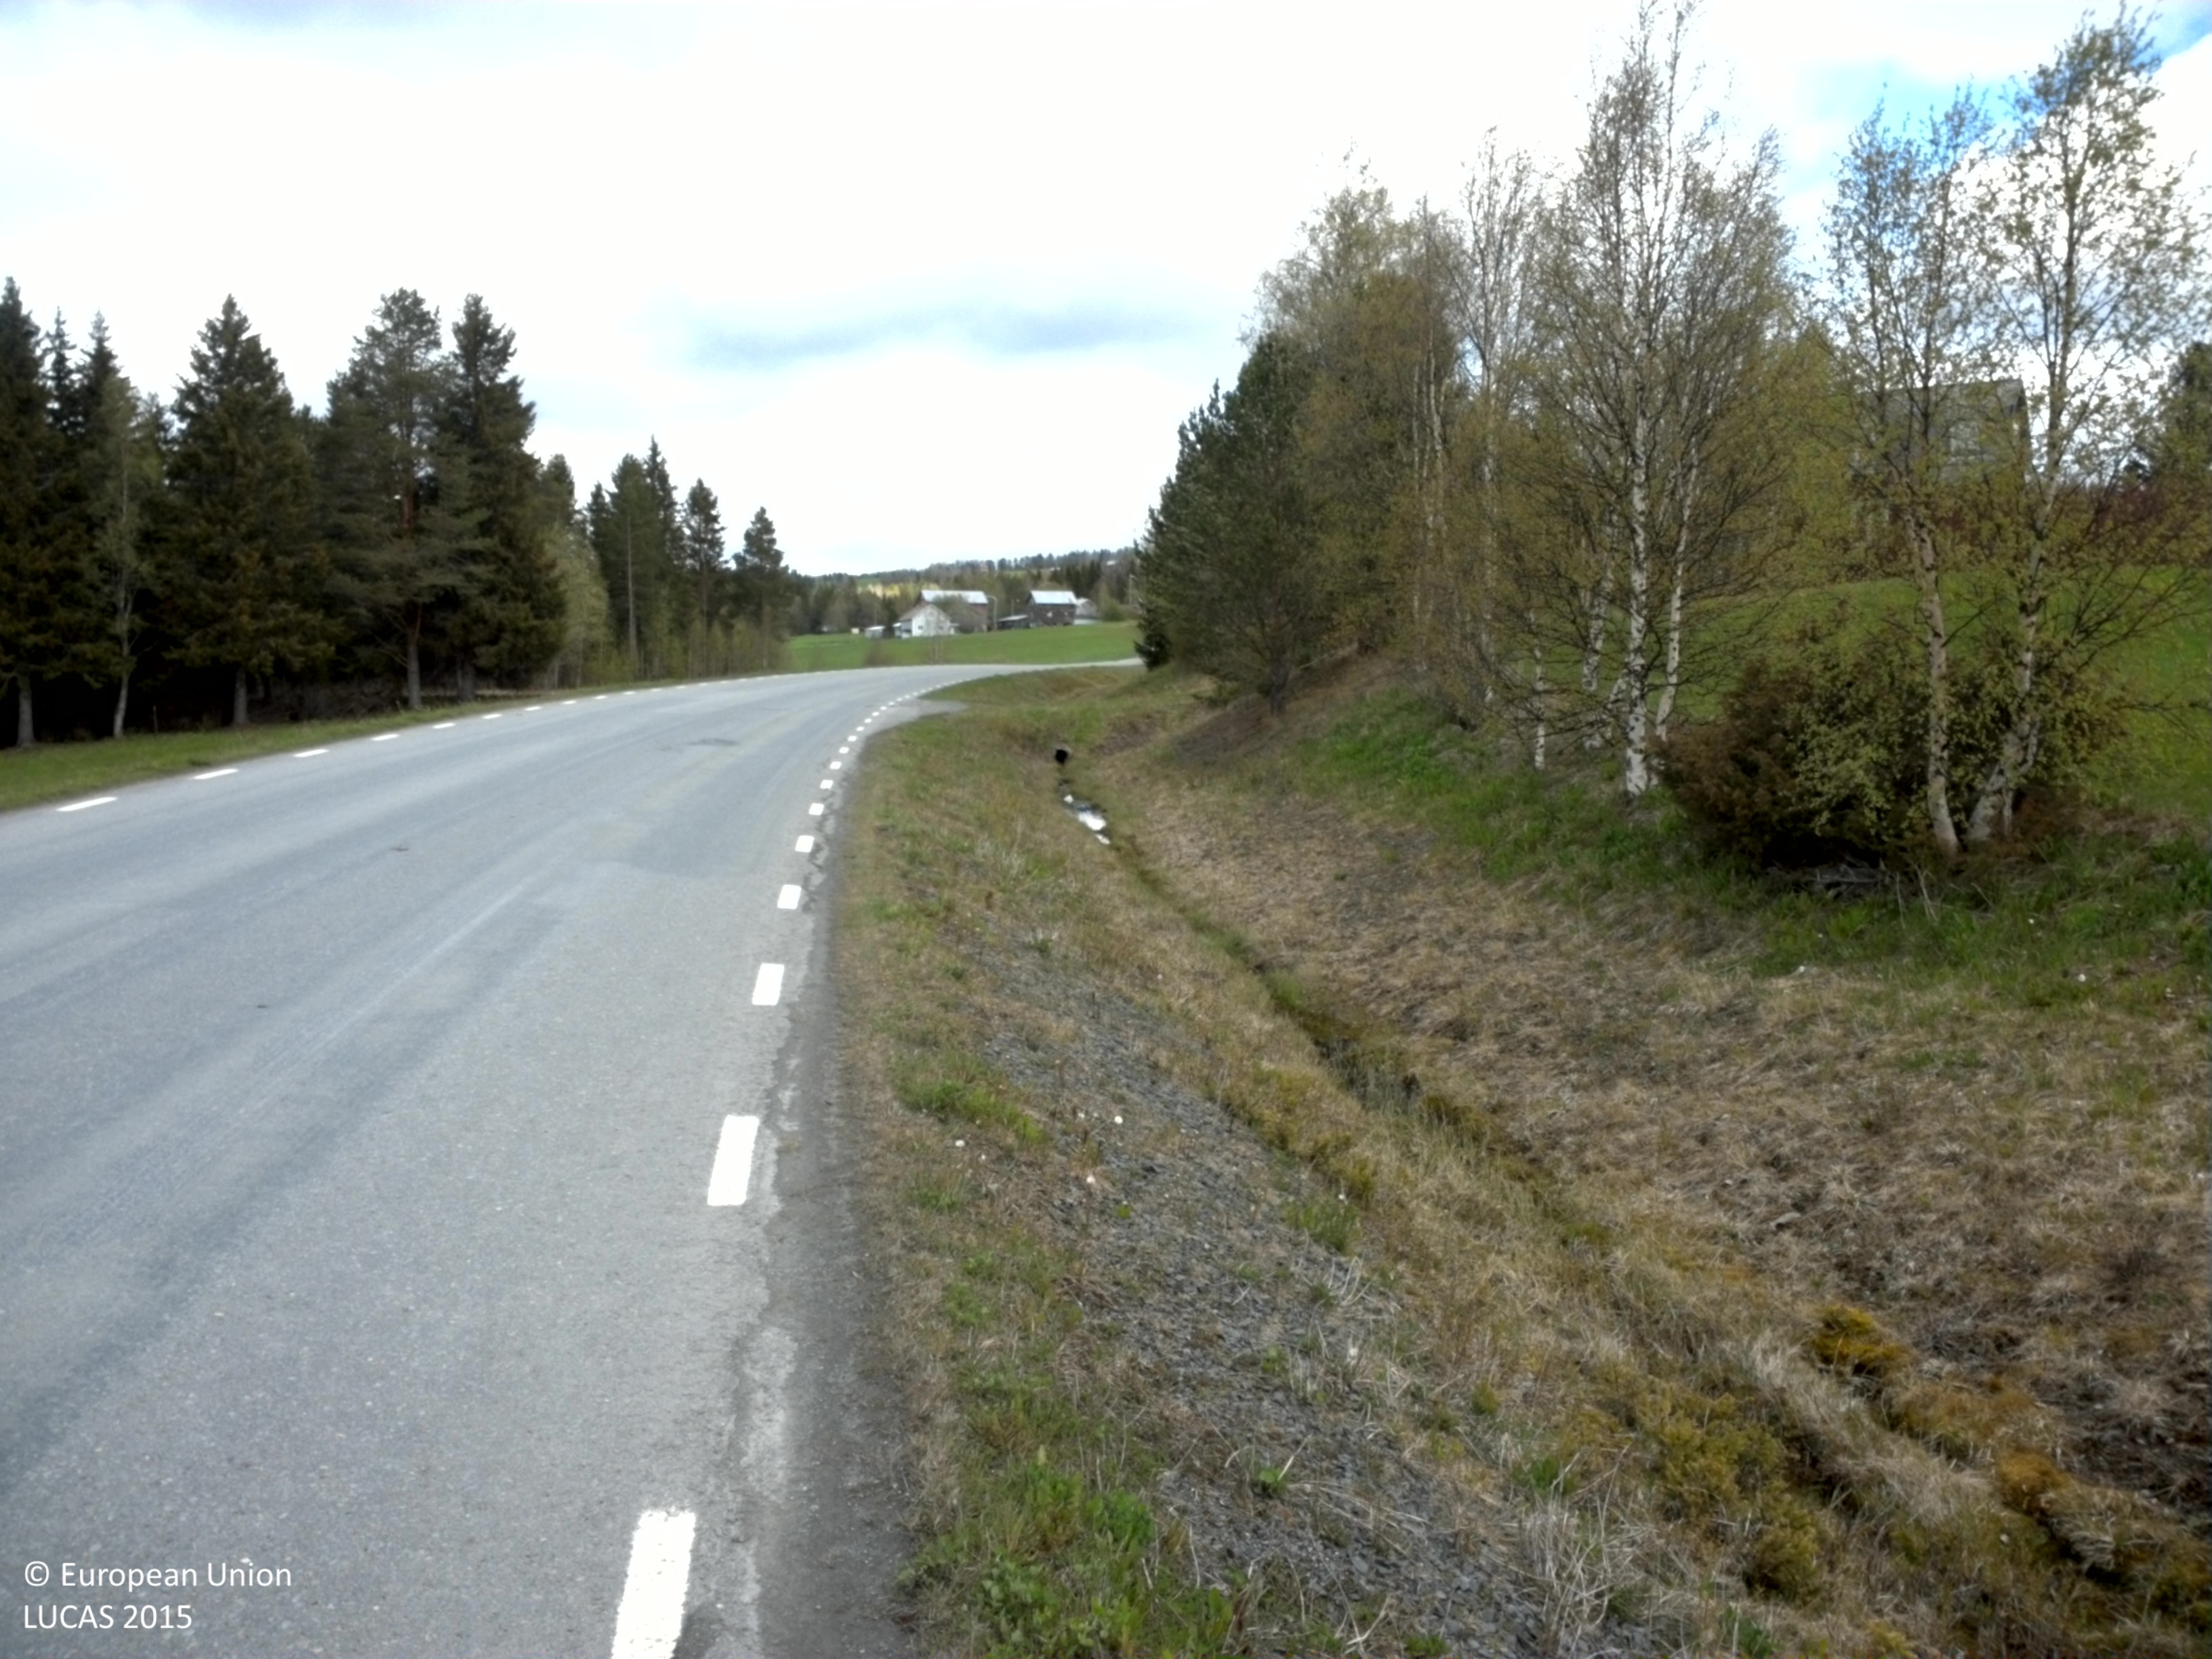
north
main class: Cropland
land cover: Other leguminous and mixtures for fodder
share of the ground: > 75 %
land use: Agriculture (excluding fallow land and kitchen gardens)
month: June
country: SE
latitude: 63.5009
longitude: 13.8973
